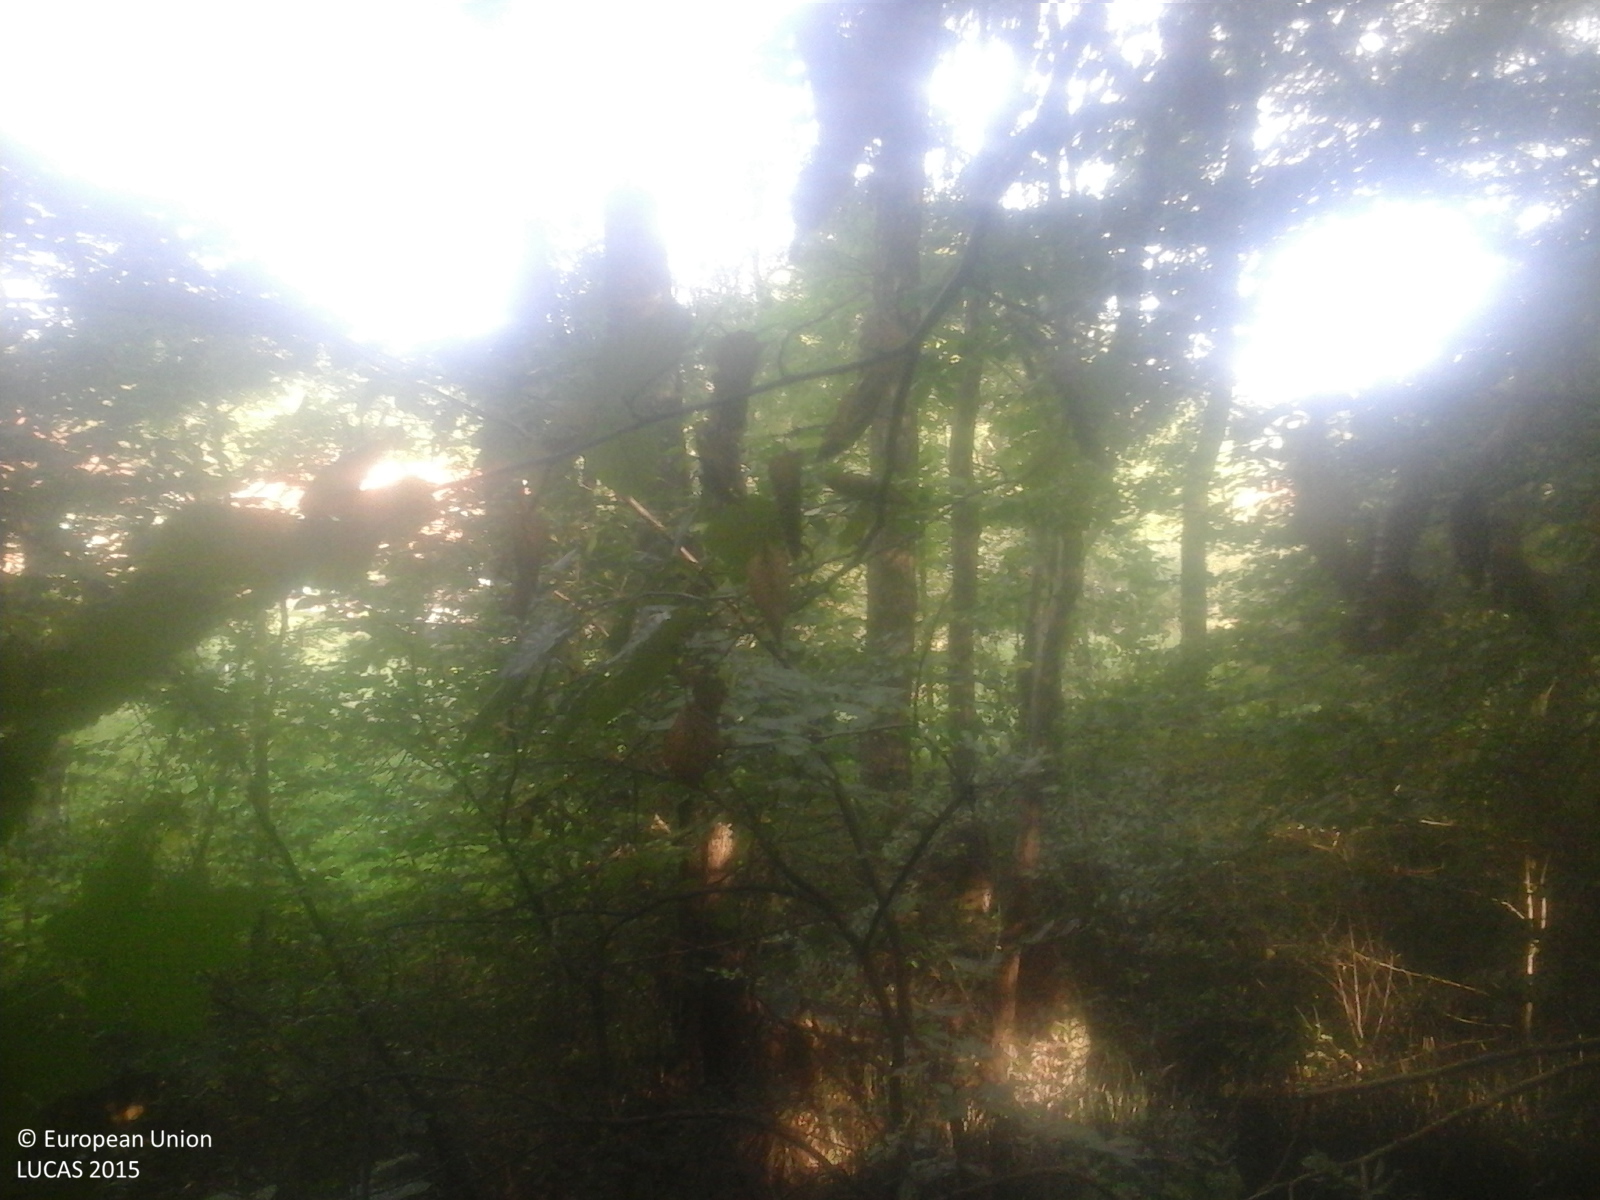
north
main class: Woodland
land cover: Broadleaved woodland
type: beech forest
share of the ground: > 75 %
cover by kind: broadleaved forest trees 100 %
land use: Forestry
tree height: > 5 m
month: September
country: RO
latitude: 46.0689
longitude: 22.8141
